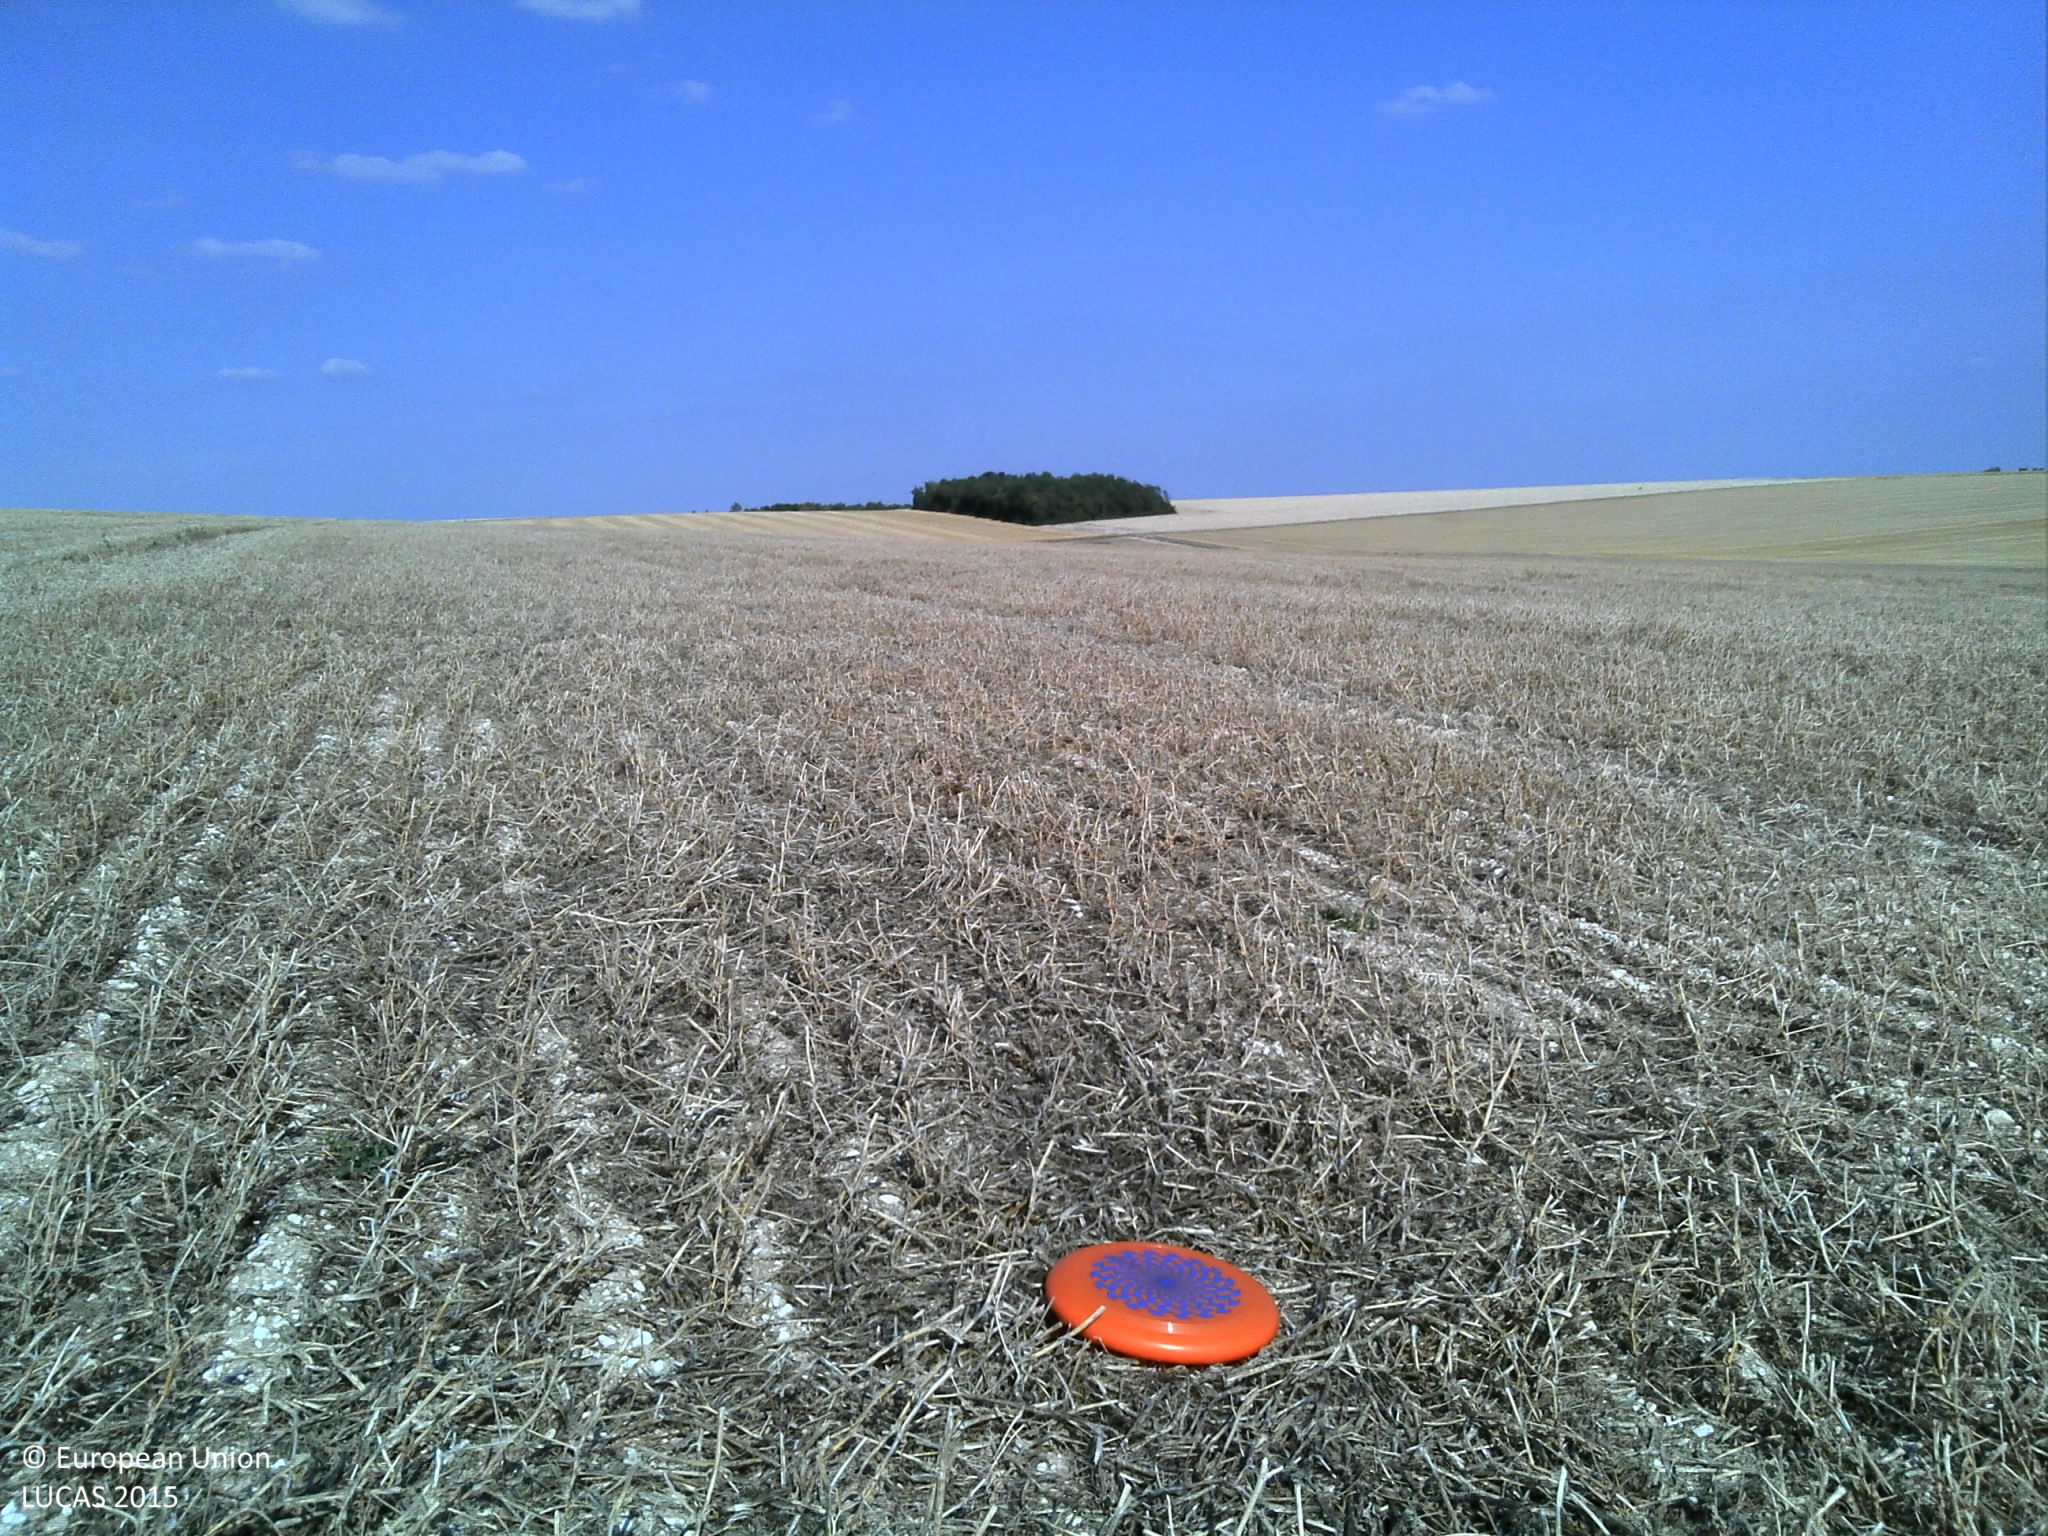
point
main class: Cropland
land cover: Dry pulses
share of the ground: > 75 %
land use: Agriculture (excluding fallow land and kitchen gardens)
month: August
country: FR
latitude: 48.9402
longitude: 4.6316
